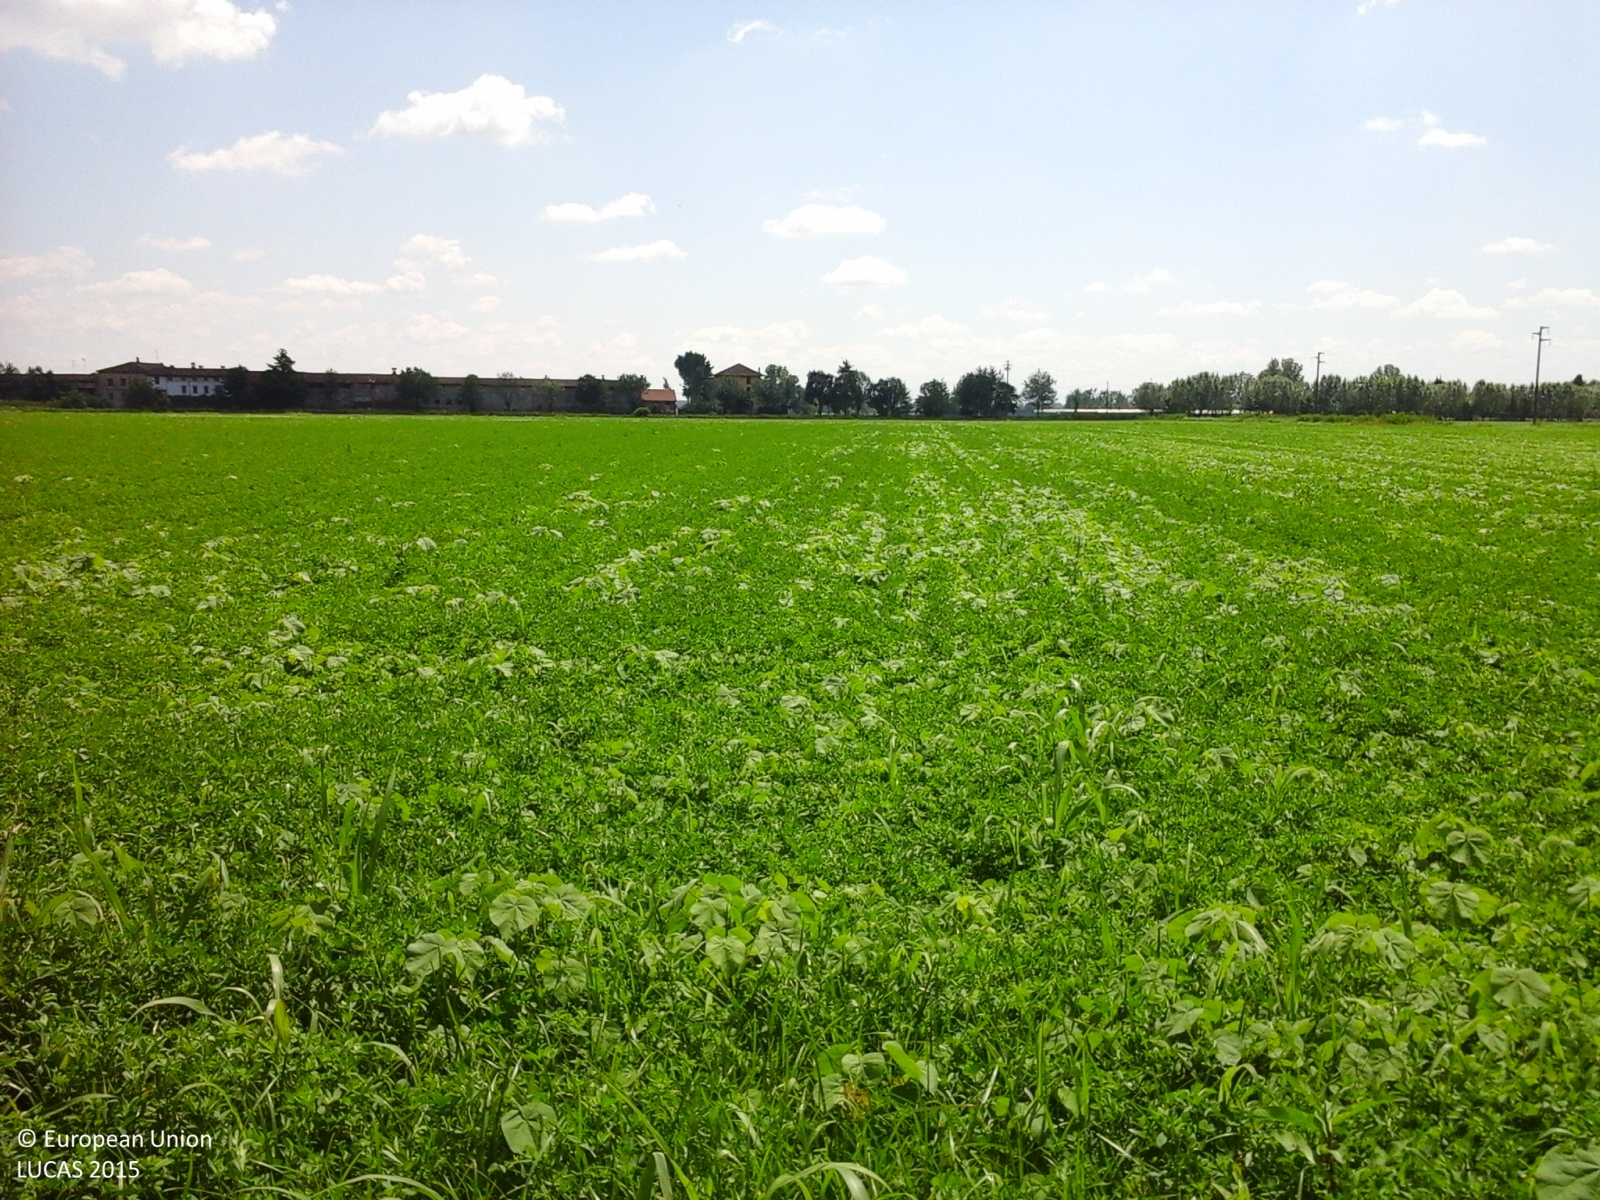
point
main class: Cropland
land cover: Lucerne
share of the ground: > 75 %
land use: Agriculture (excluding fallow land and kitchen gardens)
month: May
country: IT
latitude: 45.4318
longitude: 9.6555
